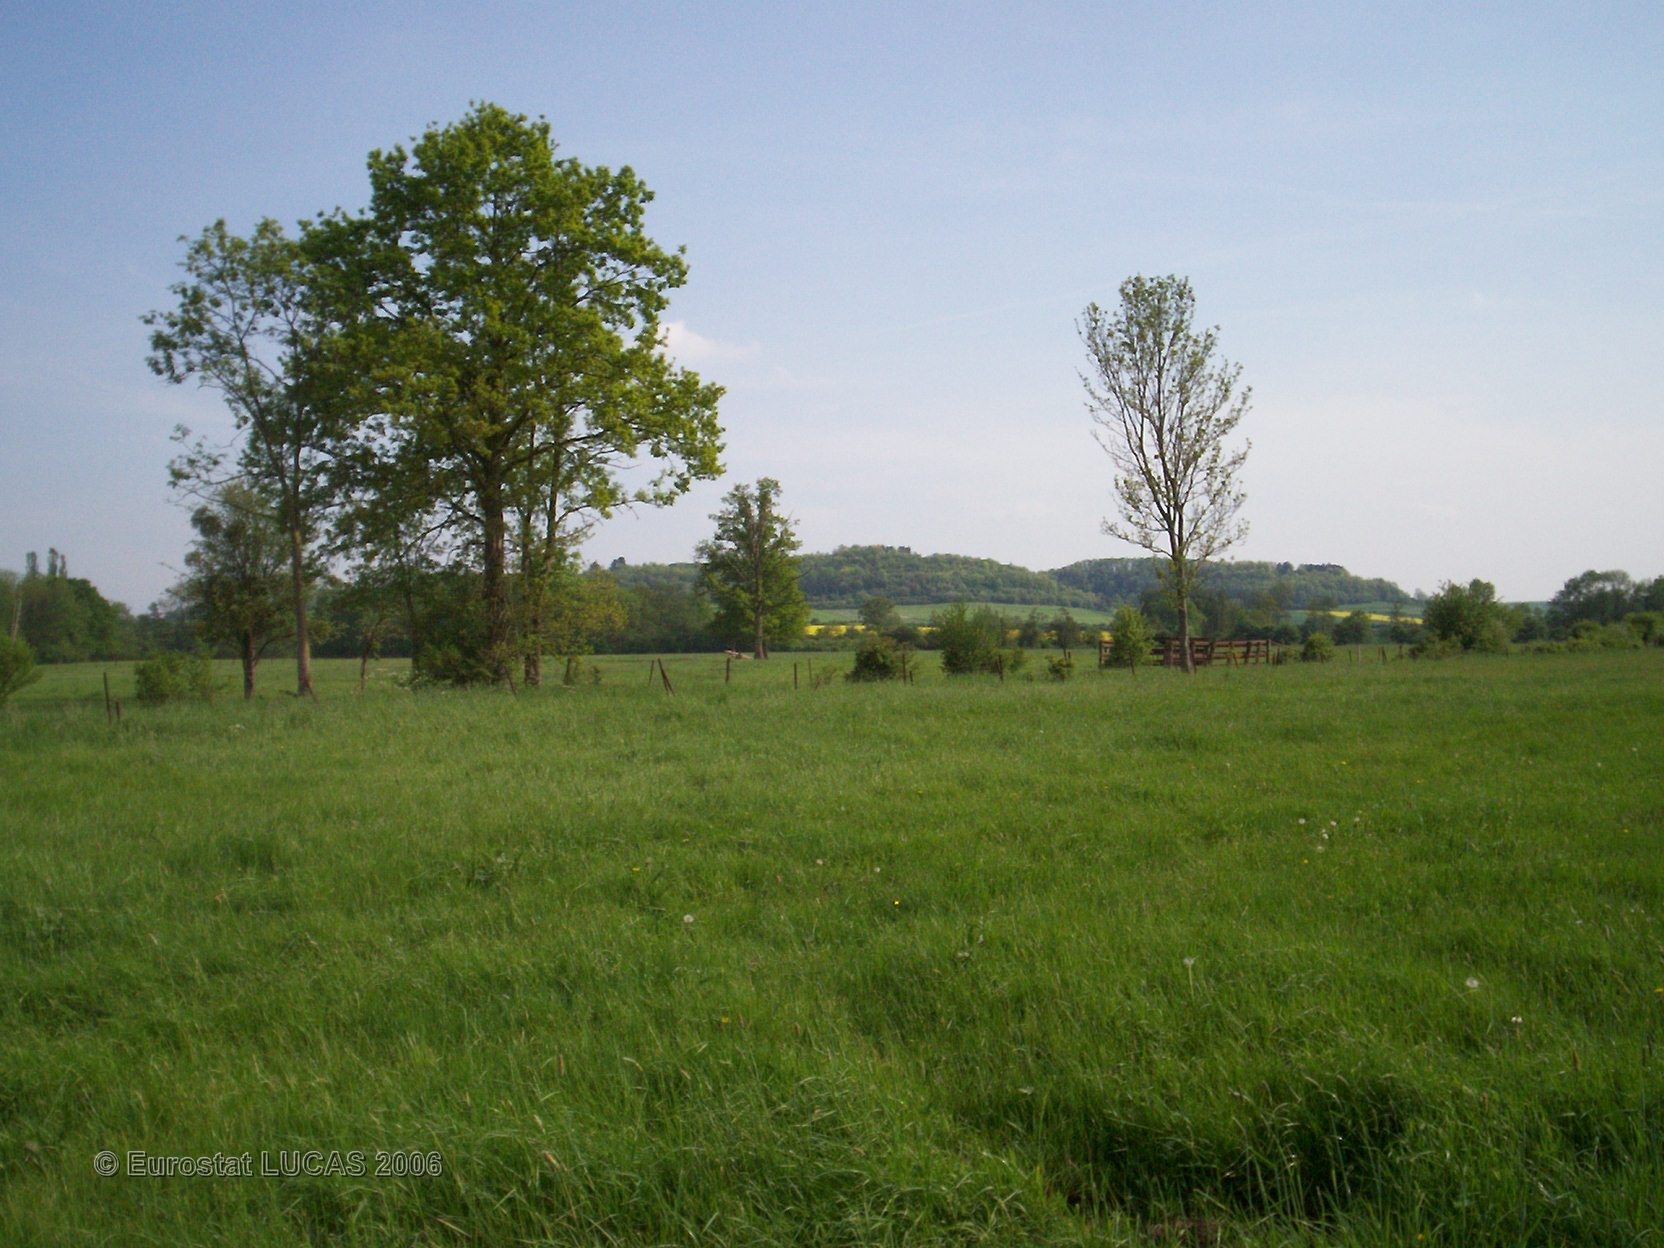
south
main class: Grassland
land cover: Grassland without tree/shrub cover
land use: Agriculture (excluding fallow land and kitchen gardens)
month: May
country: FR
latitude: 49.6108
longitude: 4.3354
